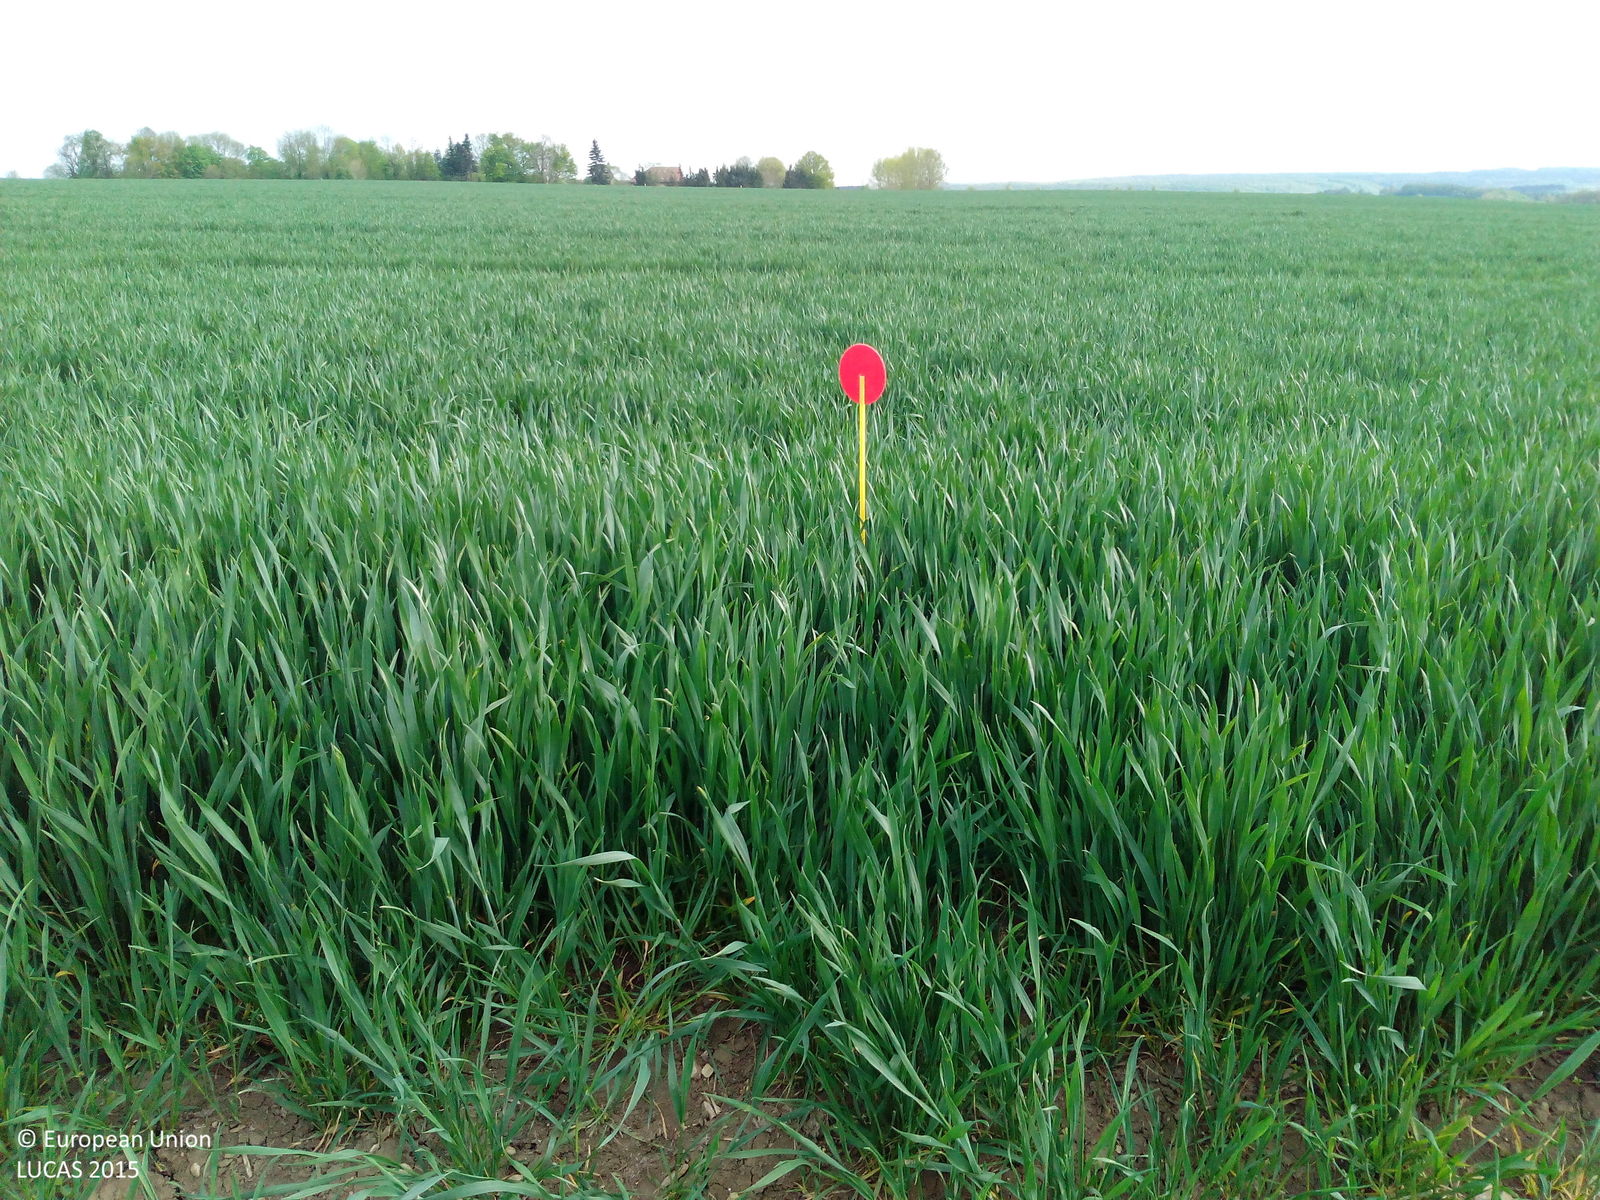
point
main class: Cropland
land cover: Common wheat
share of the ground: > 75 %
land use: Agriculture (excluding fallow land and kitchen gardens)
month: May
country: DE
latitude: 50.9650
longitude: 11.5517
